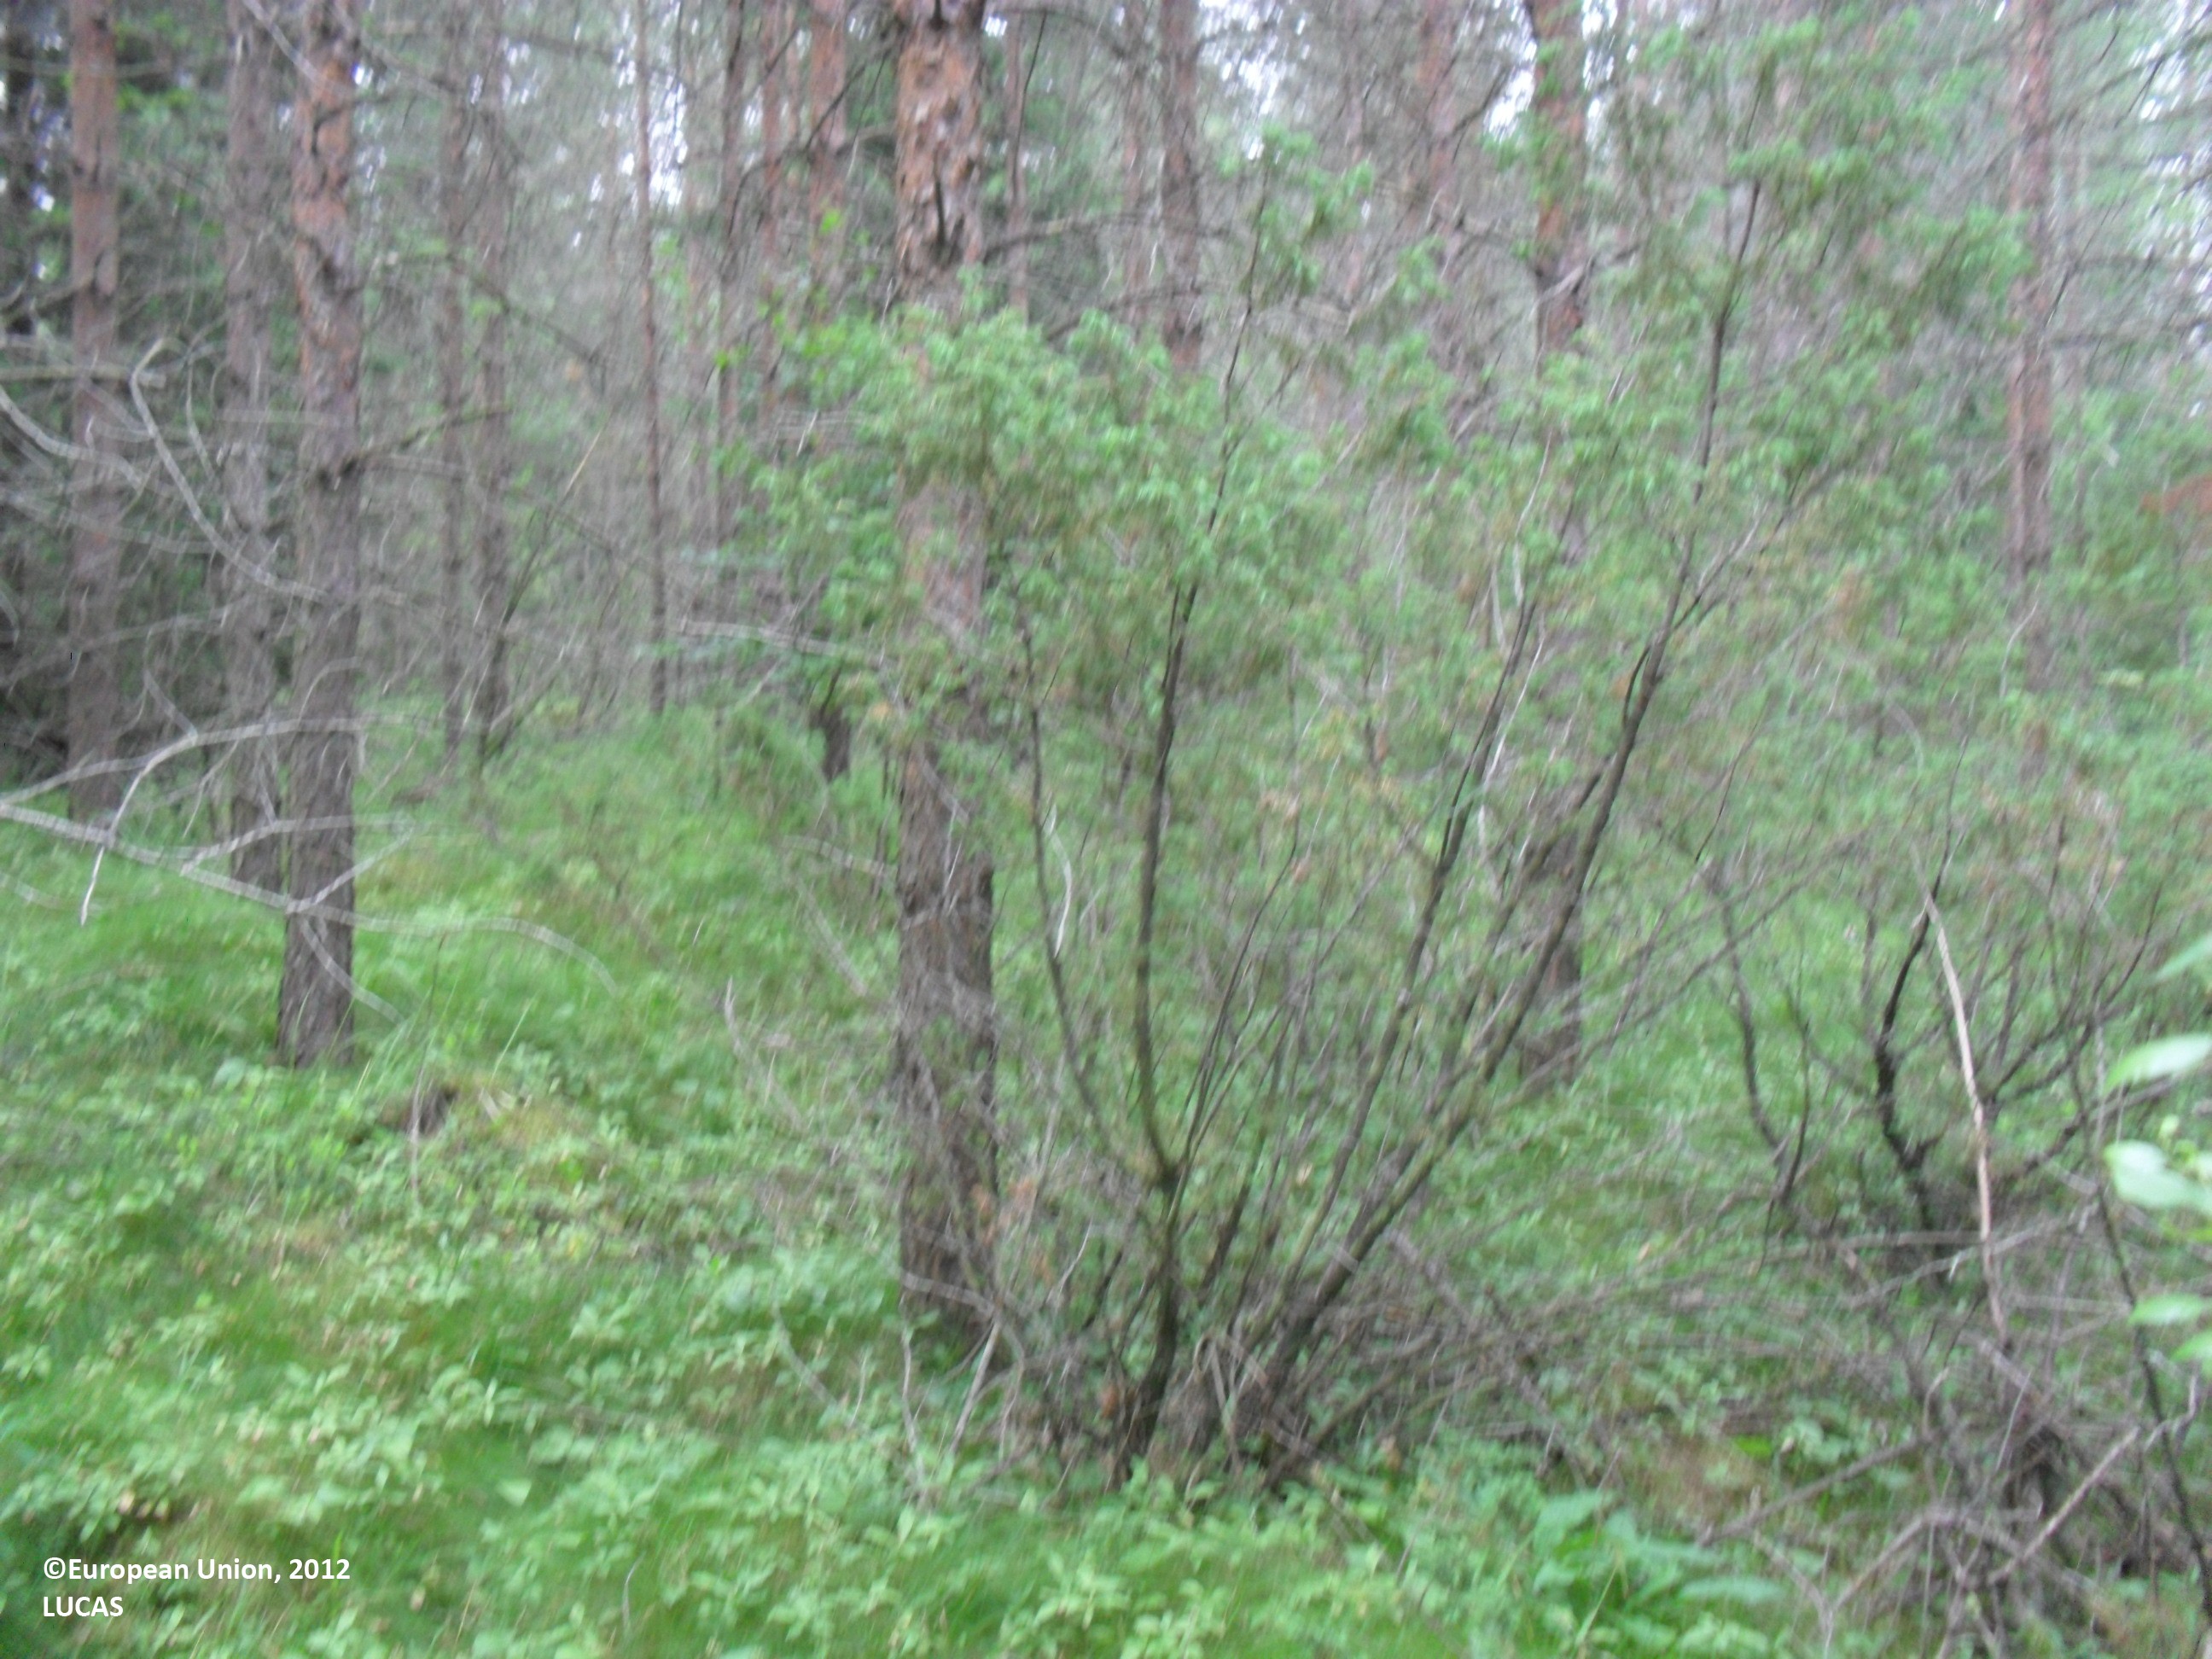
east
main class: Woodland
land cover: Pine dominated mixed woodland
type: boreal forest
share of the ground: 50 - 75 %
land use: Forestry
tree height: > 5 m
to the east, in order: Pine dominated mixed woodland; Ditches and canals; Paved roads, cycling and walking lanes; Ditches and canals; Pine dominated mixed woodland; Other mixed woodland; Ditches and canals; Pine dominated mixed woodland; Pine dominated coniferous woodland; Ditches and canals; Other mixed woodland
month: July
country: FI
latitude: 63.5832
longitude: 23.6627
